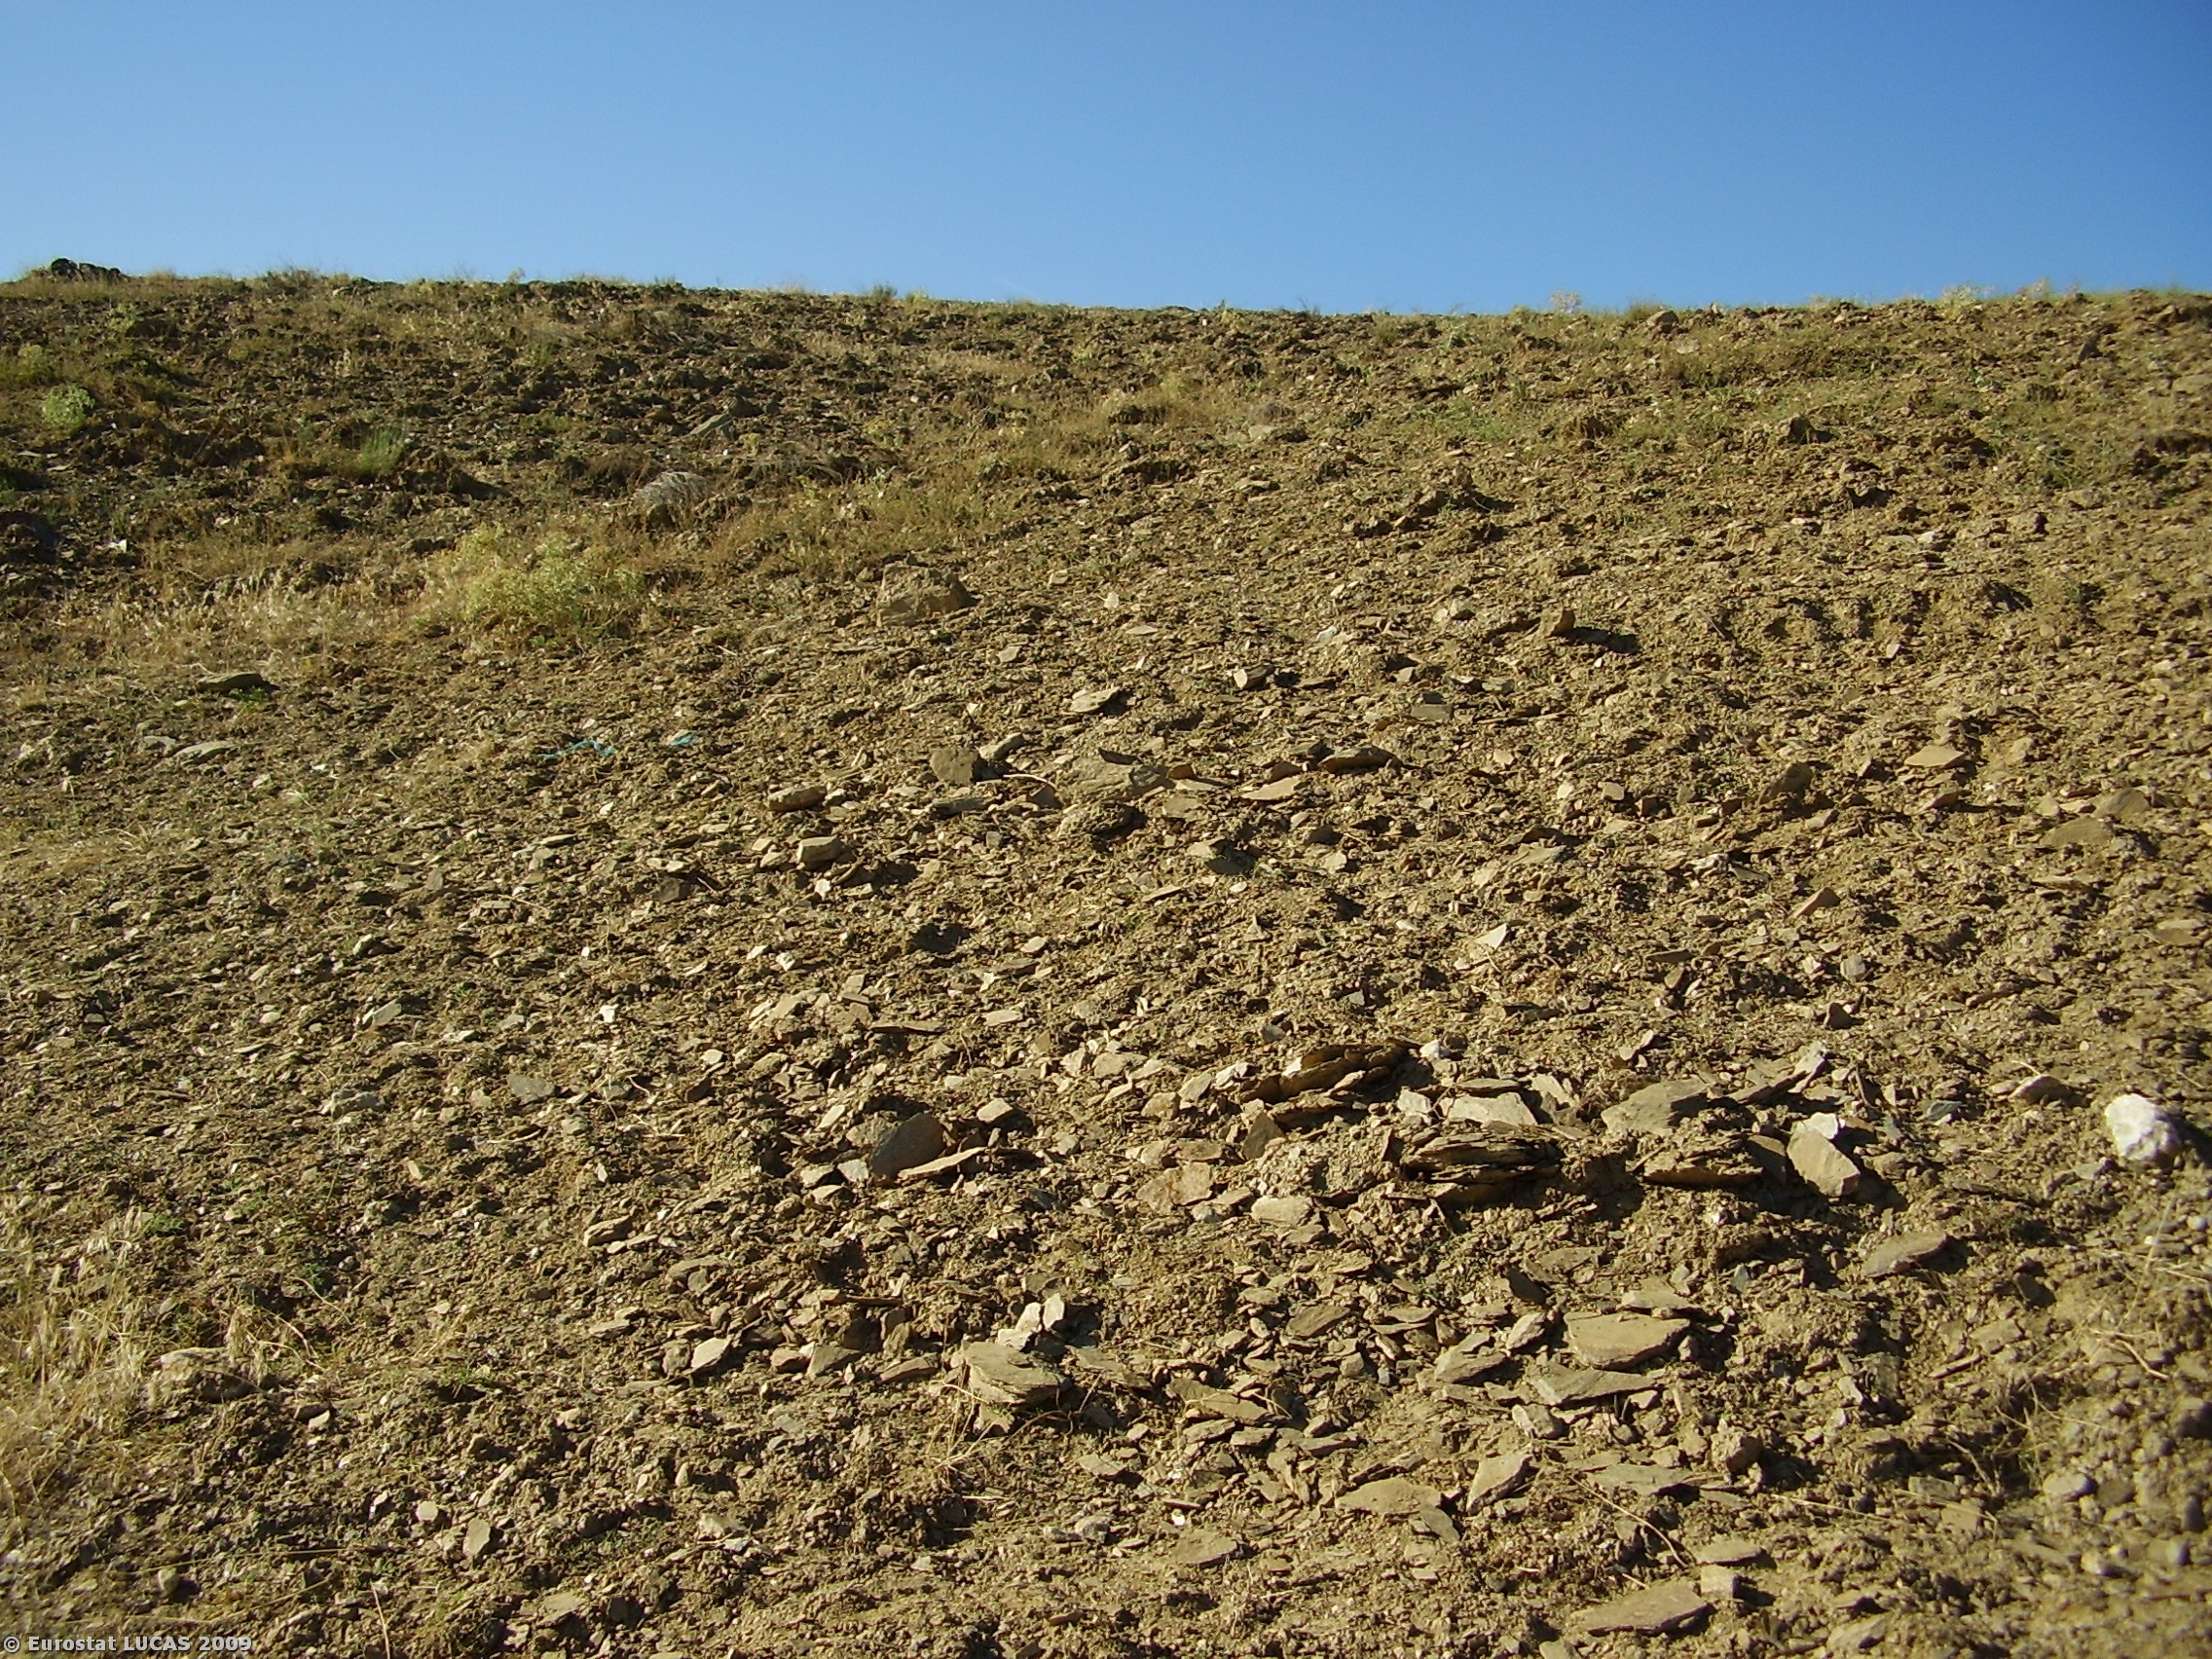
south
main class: Cropland
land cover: Olive groves
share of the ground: 10 - 25 %
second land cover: Spontaneously vegetated surfaces
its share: < 10 %
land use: Agriculture (excluding fallow land and kitchen gardens)
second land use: Fallow land
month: August
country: PT
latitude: 41.4270
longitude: -6.7768
